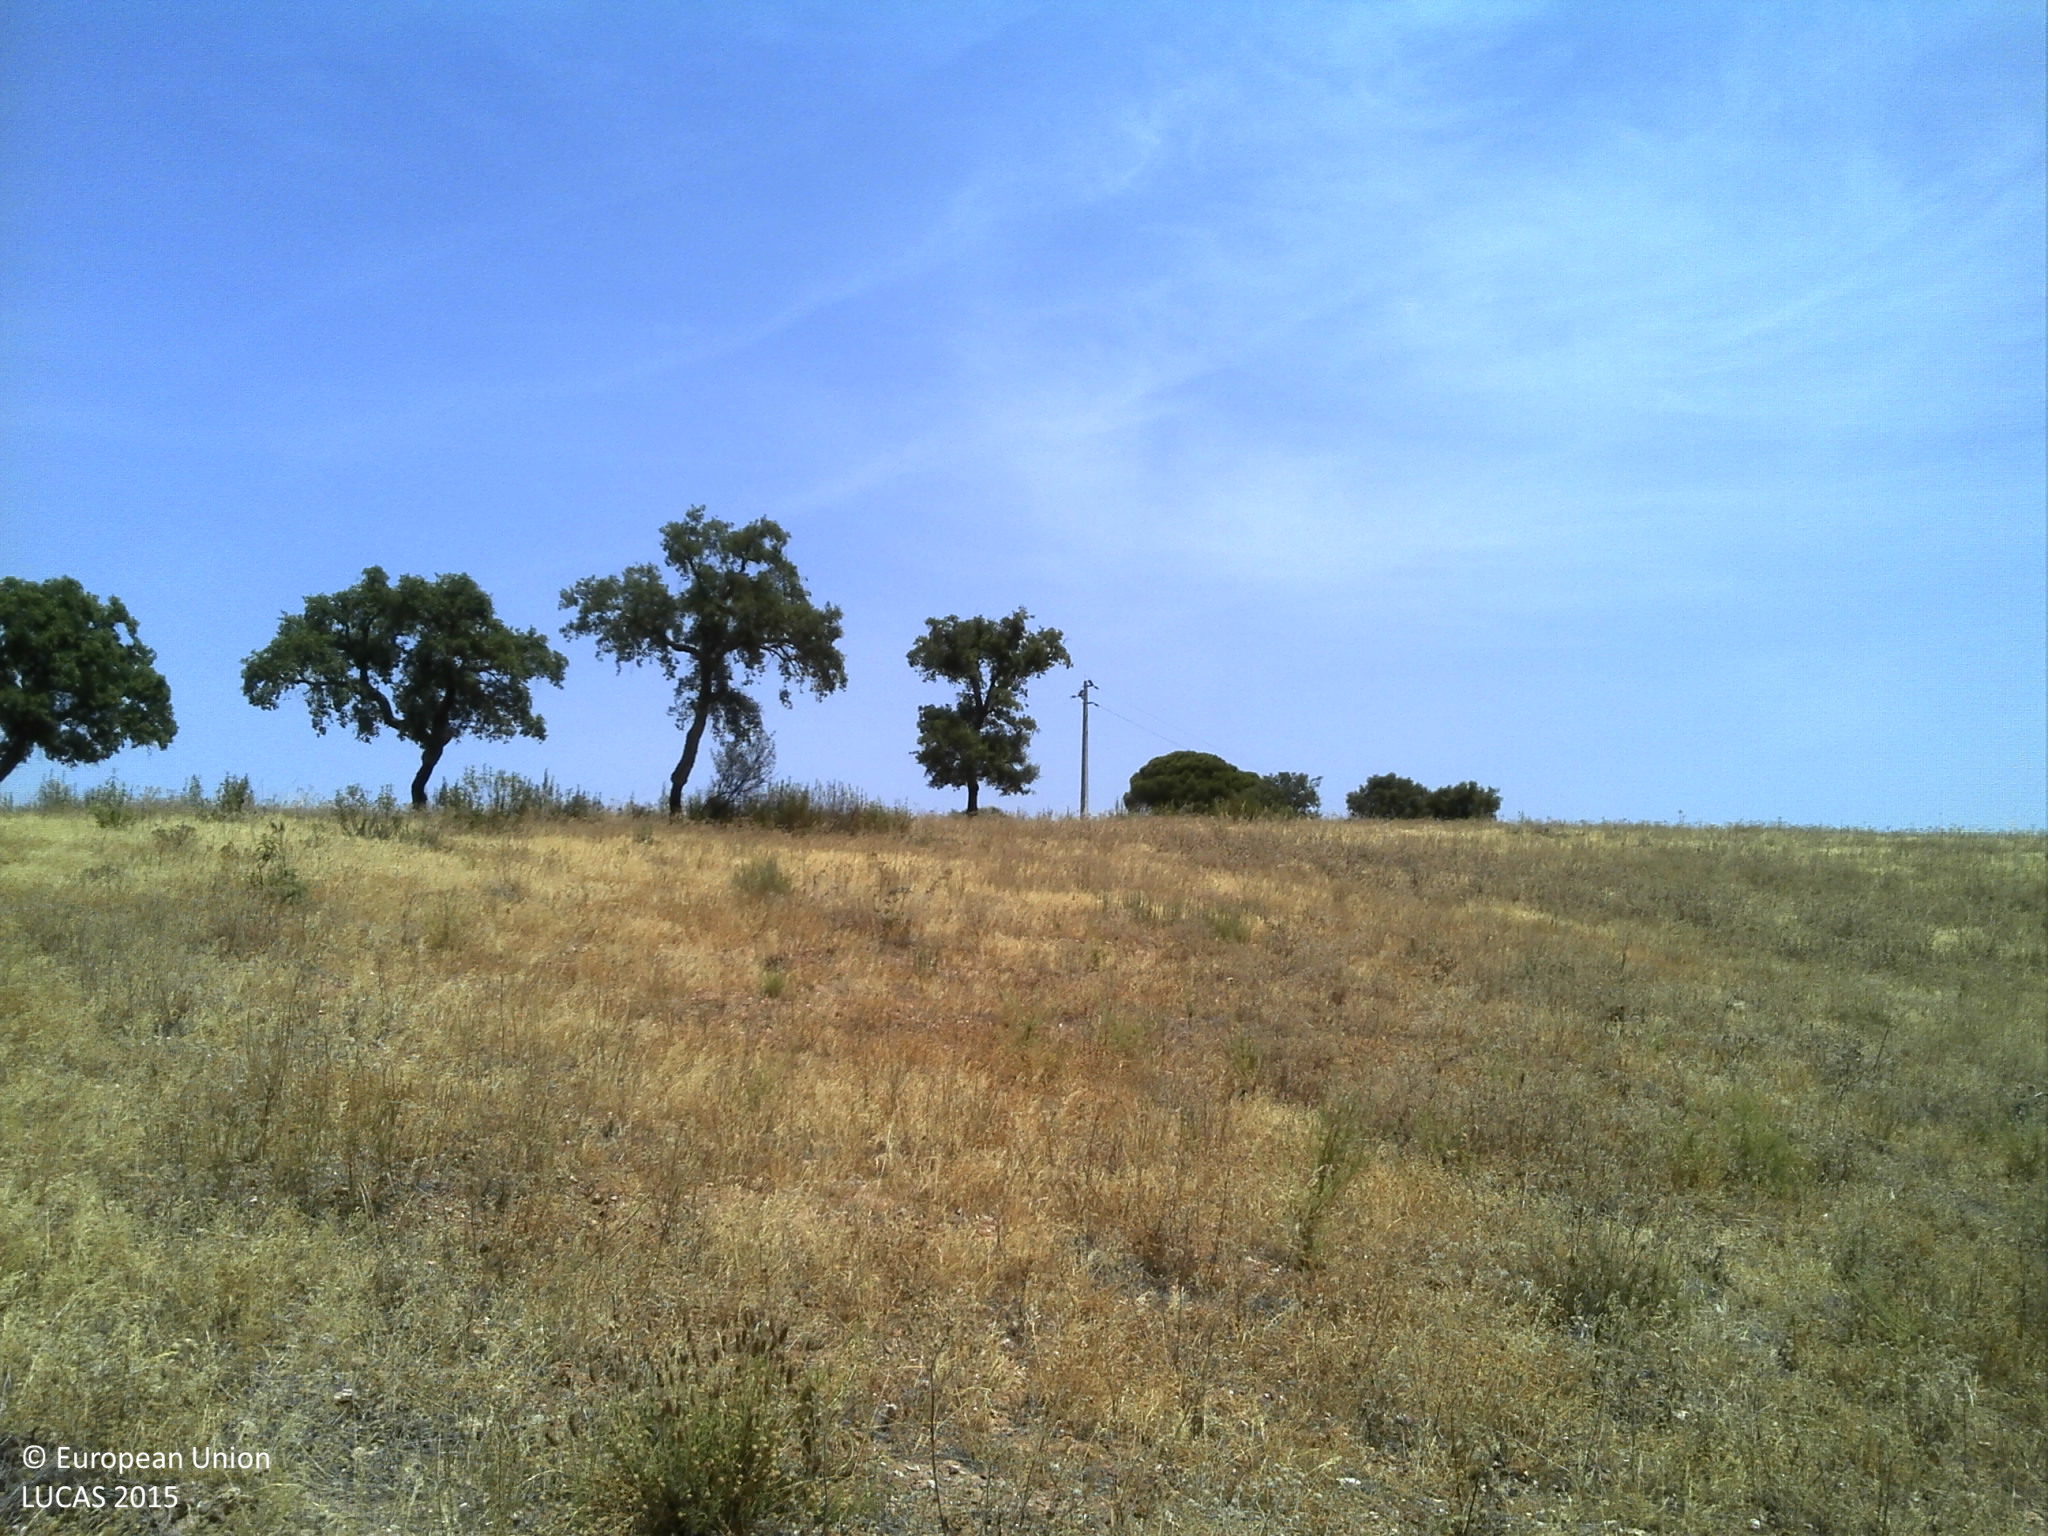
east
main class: Grassland
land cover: Grassland without tree/shrub cover
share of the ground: 25 - 50 %
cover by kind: unconsolidated bare surface 75 %, herbaceous plants 25 %
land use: Agriculture (excluding fallow land and kitchen gardens)
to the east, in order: Grassland without tree/shrub cover; Broadleaved woodland; Grassland with sparse tree/shrub cover; Pine dominated coniferous woodland; Tracks; Electric lines; Grassland without tree/shrub cover; Single bushes/trees
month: July
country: PT
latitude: 38.2842
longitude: -7.6450
